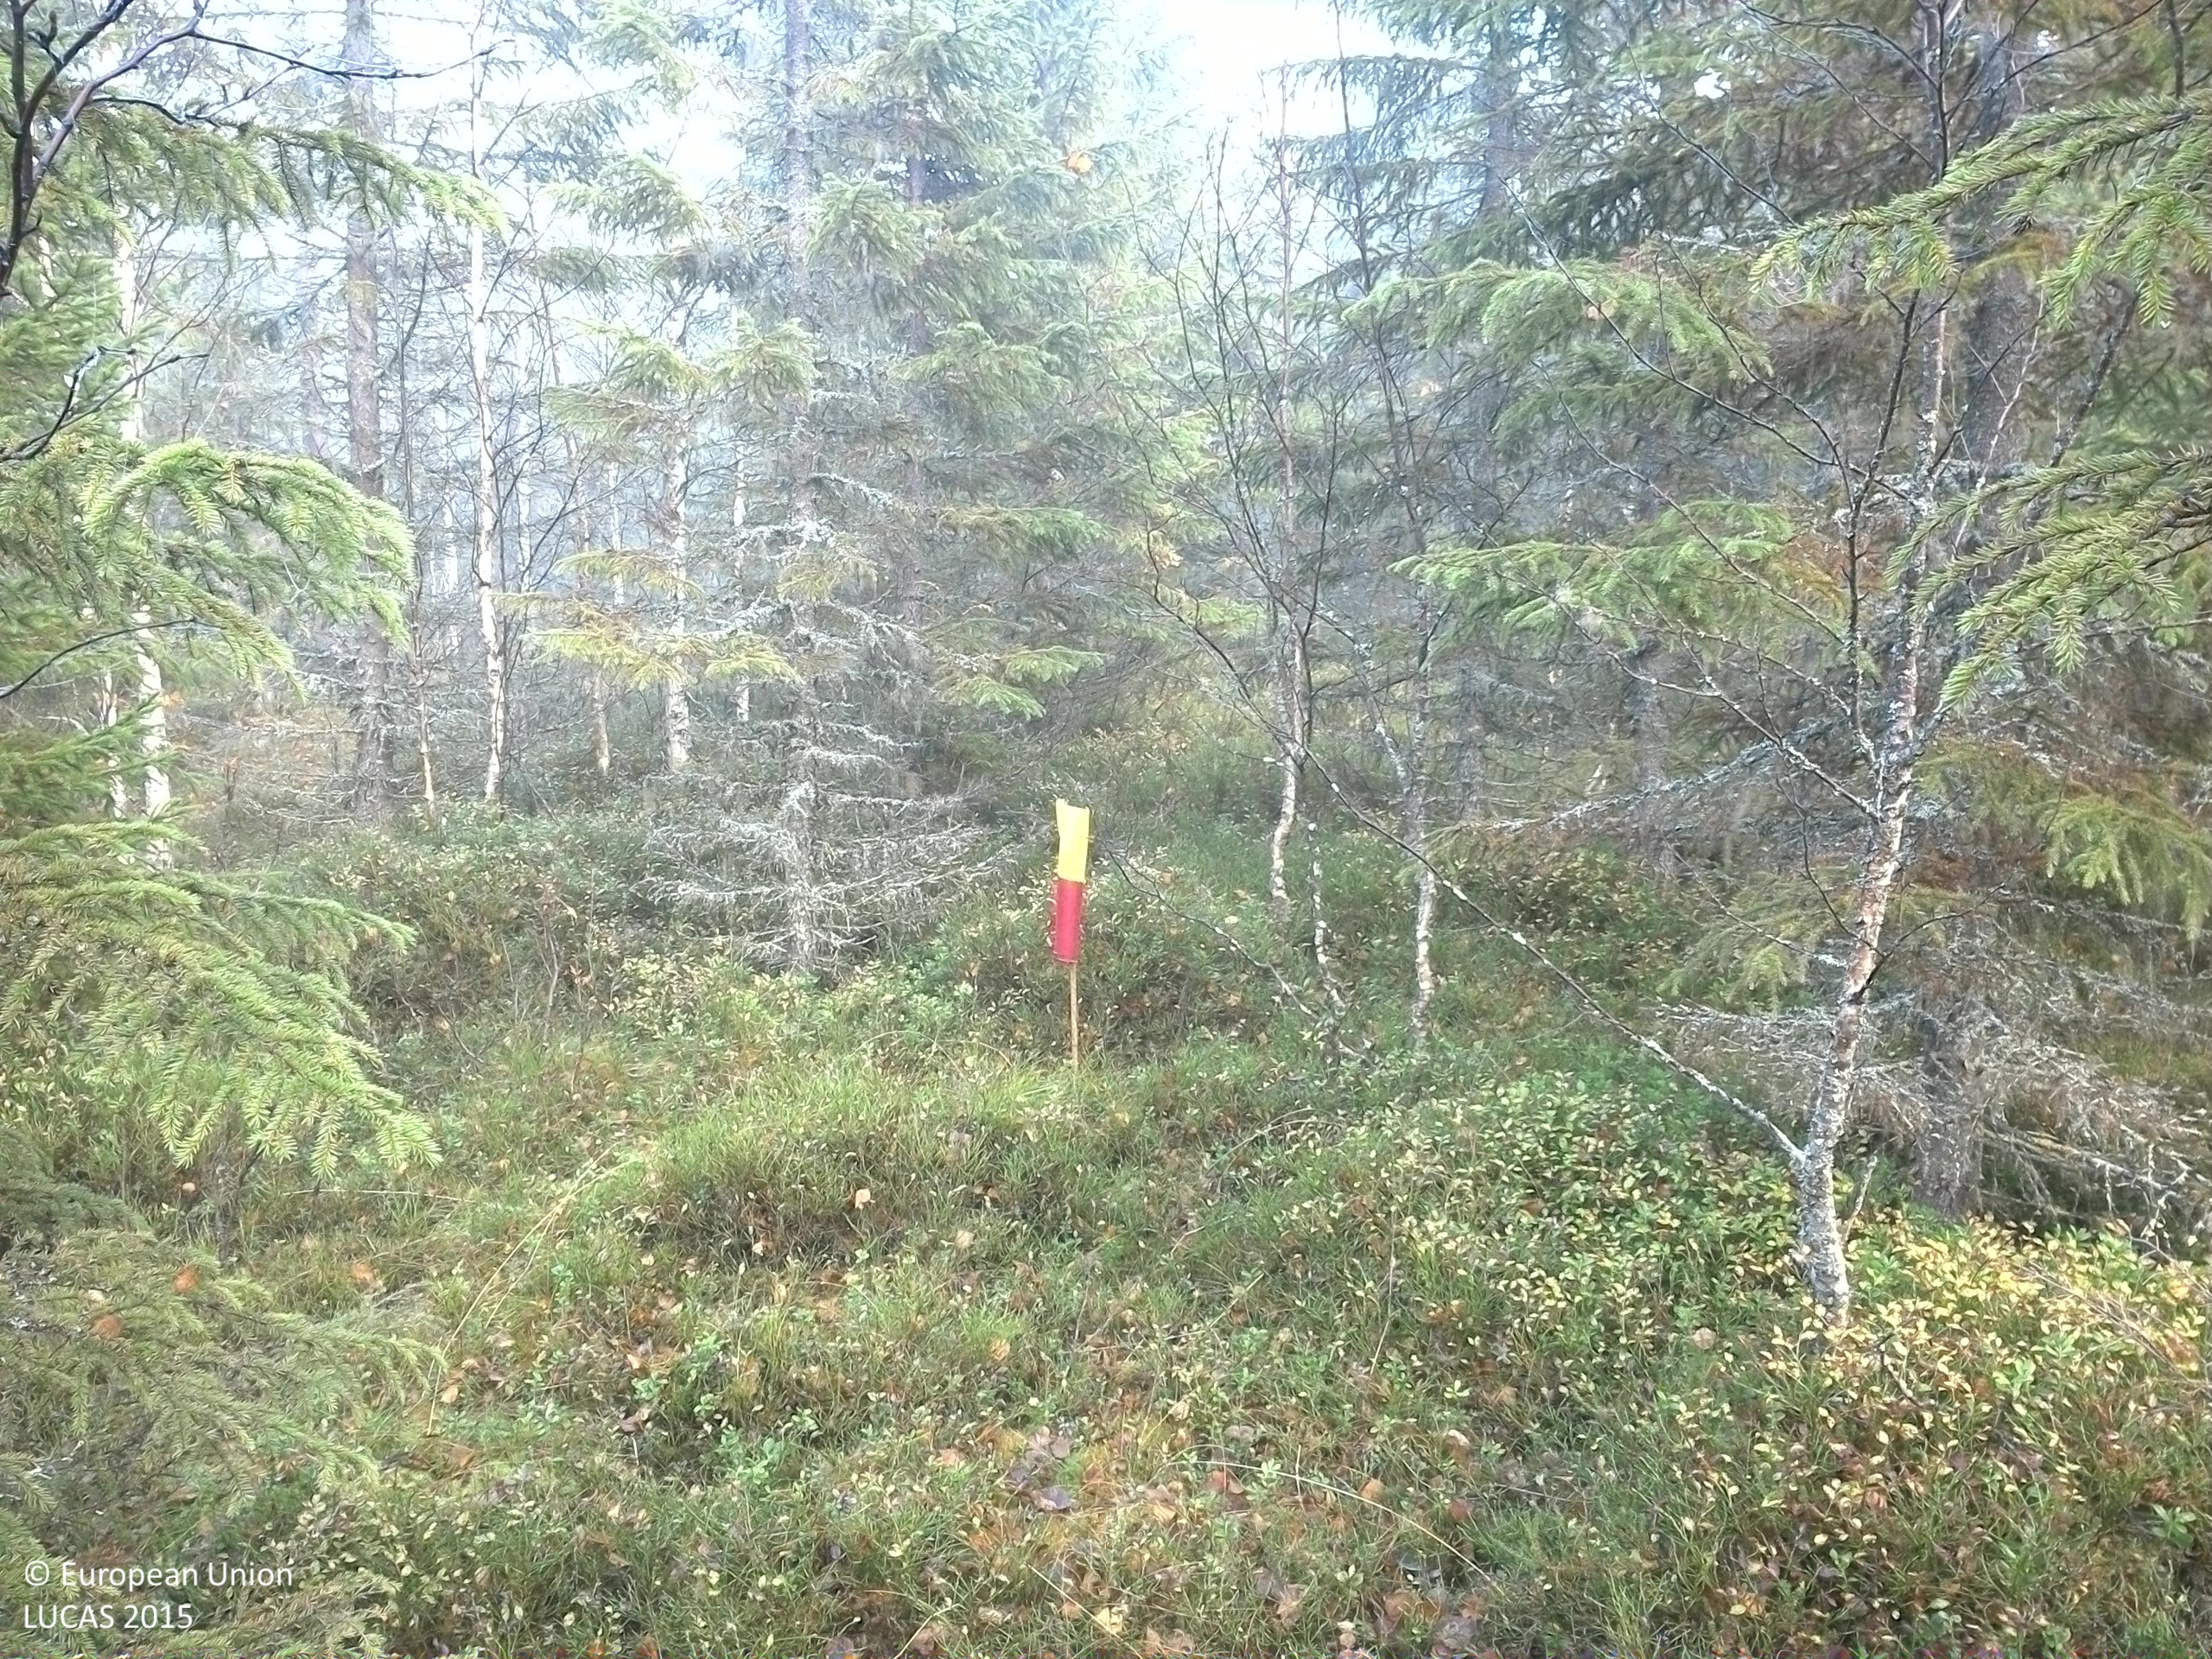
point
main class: Woodland
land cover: Spruce dominated coniferous woodland
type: boreal forest
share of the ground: 50 - 75 %
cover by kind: coniferous forest trees 50 %, shrubs 25 %, broadleaved forest trees 15 %, lichens and mosses 10 %
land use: Forestry
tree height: > 5 m
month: October
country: SE
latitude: 64.0556
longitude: 16.3011
